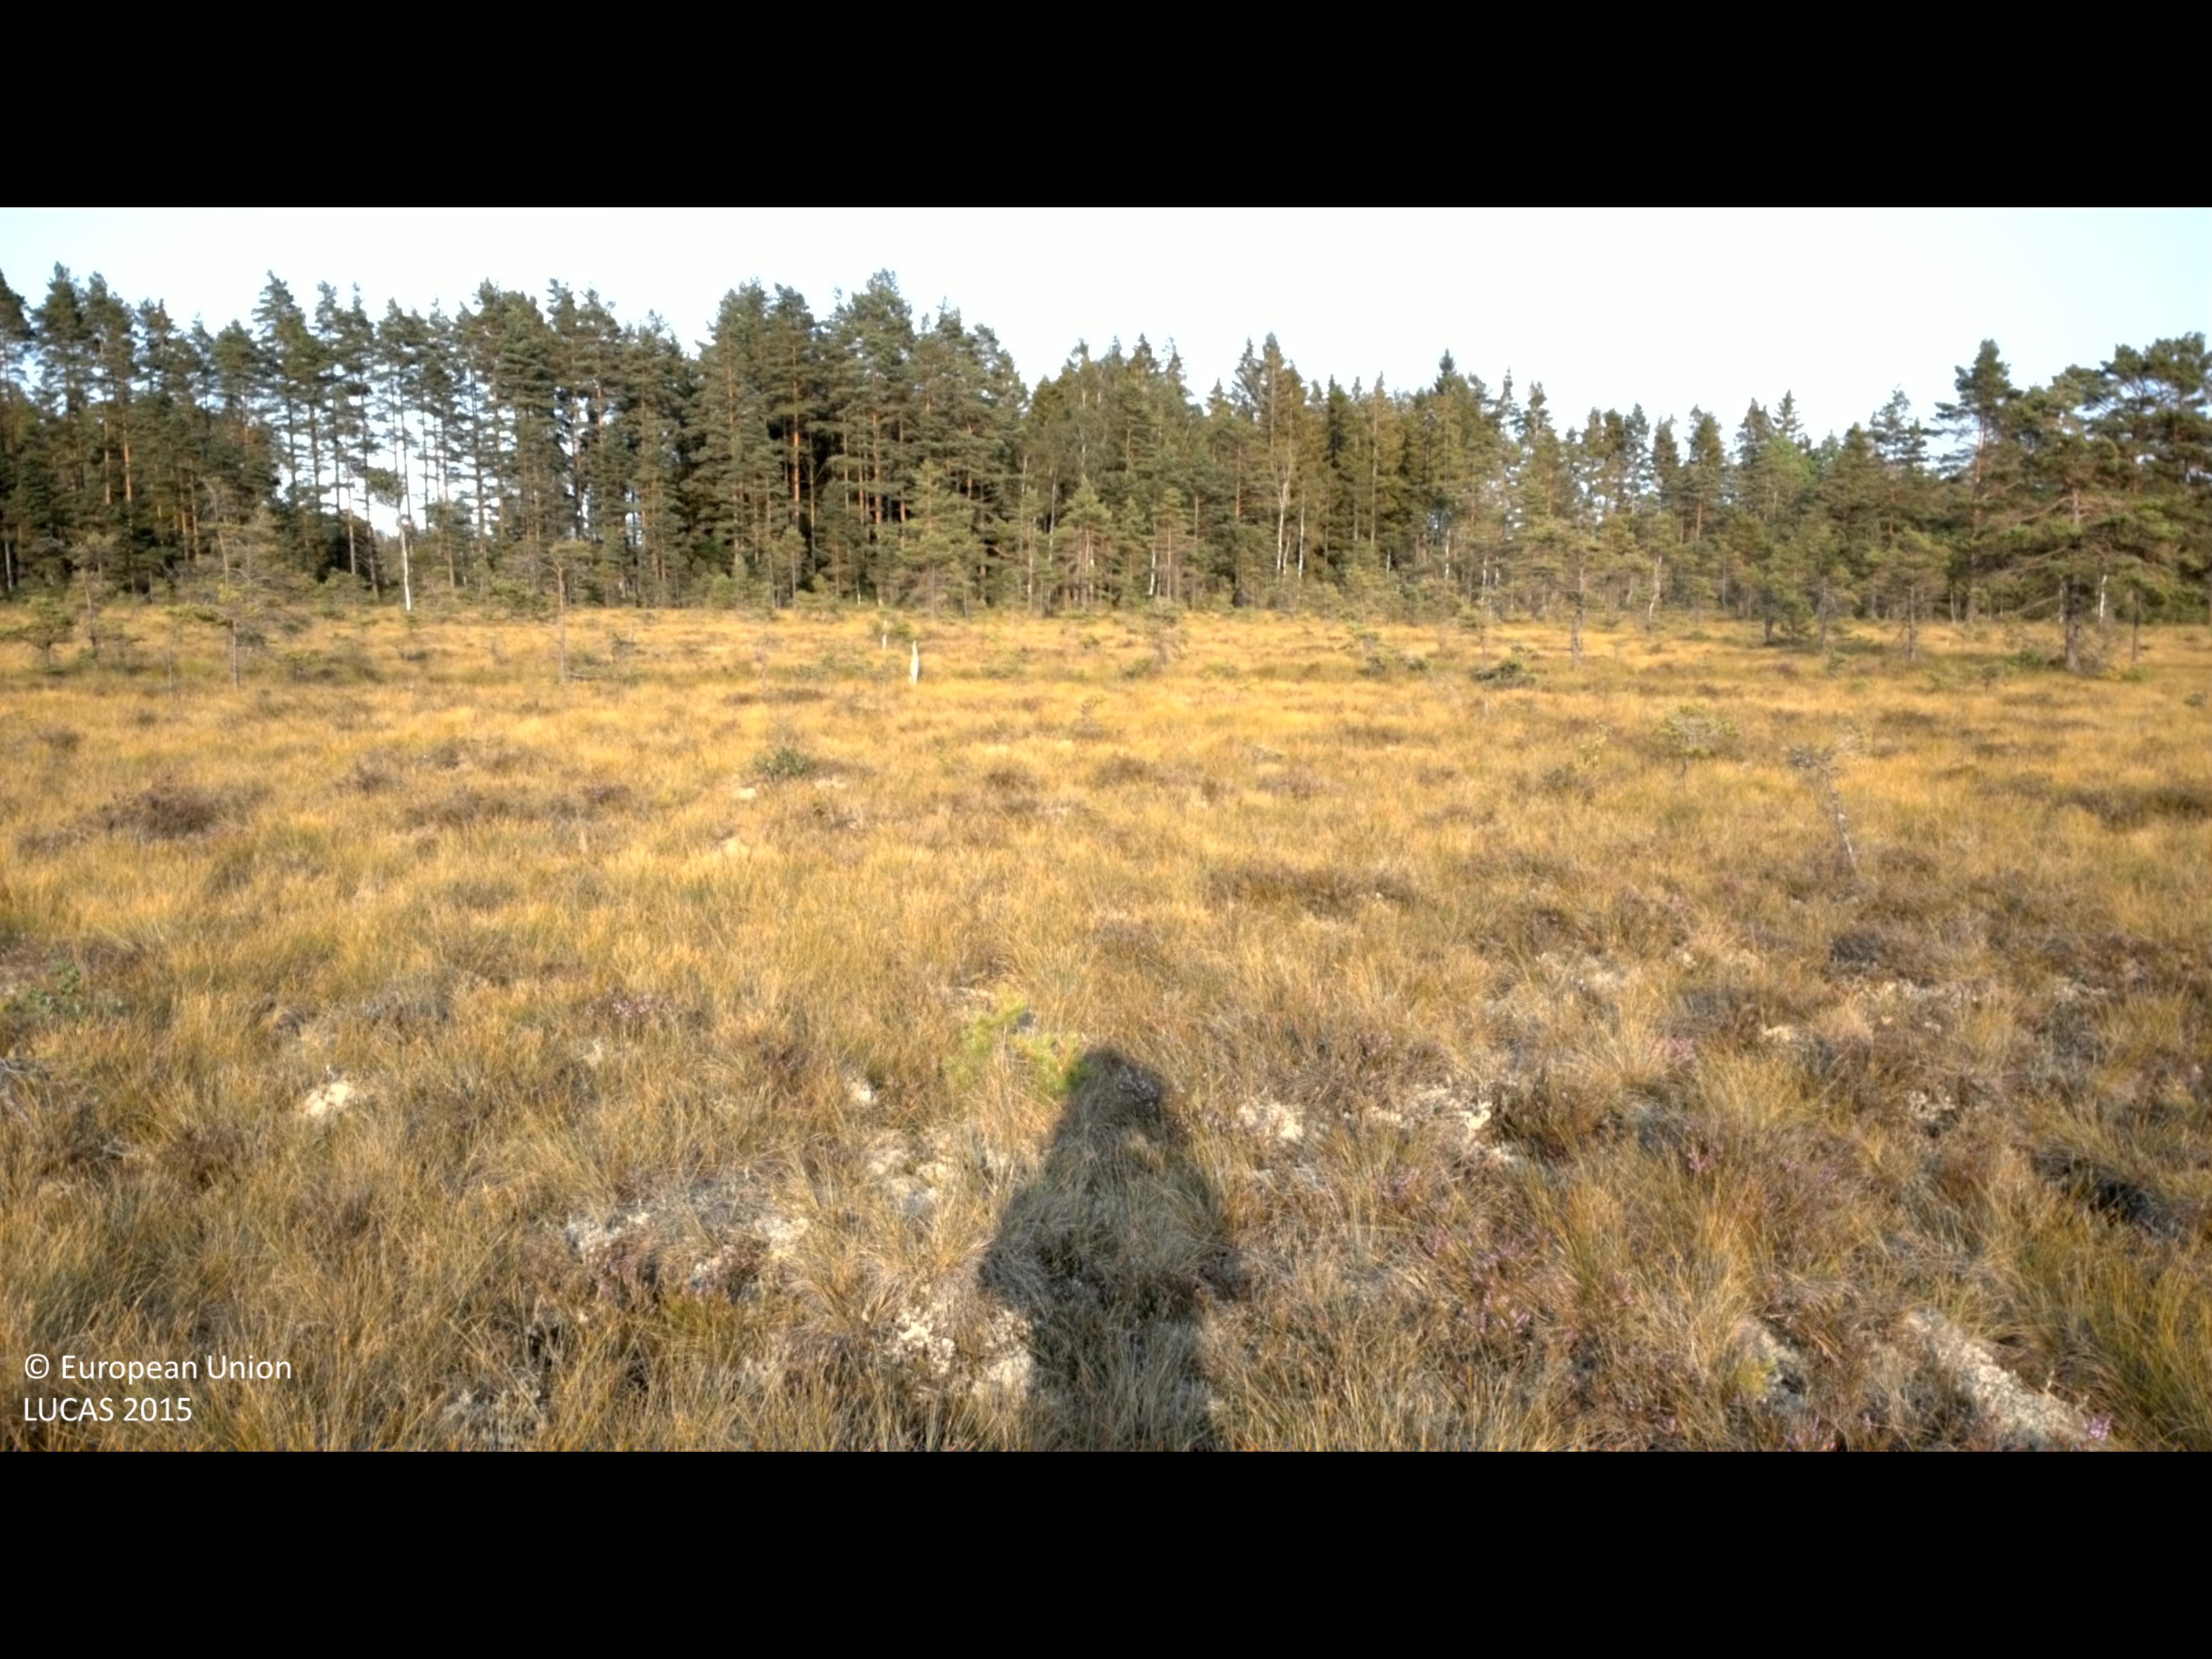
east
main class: Woodland
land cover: Pine dominated coniferous woodland
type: mire and swamp forests
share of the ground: 10 - 25 %
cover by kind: herbaceous plants 55 %, shrubs 20 %, coniferous forest trees 15 %, lichens and mosses 10 %
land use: Semi-natural and natural areas not in use
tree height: < 5 m
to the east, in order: Pine dominated coniferous woodland; Pine dominated mixed woodland; Tracks; Spruce dominated coniferous woodland; Ditches and canals; Spruce dominated mixed woodland; Ditches and canals; Spruce dominated coniferous woodland
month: August
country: SE
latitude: 56.8969
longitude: 14.0845
